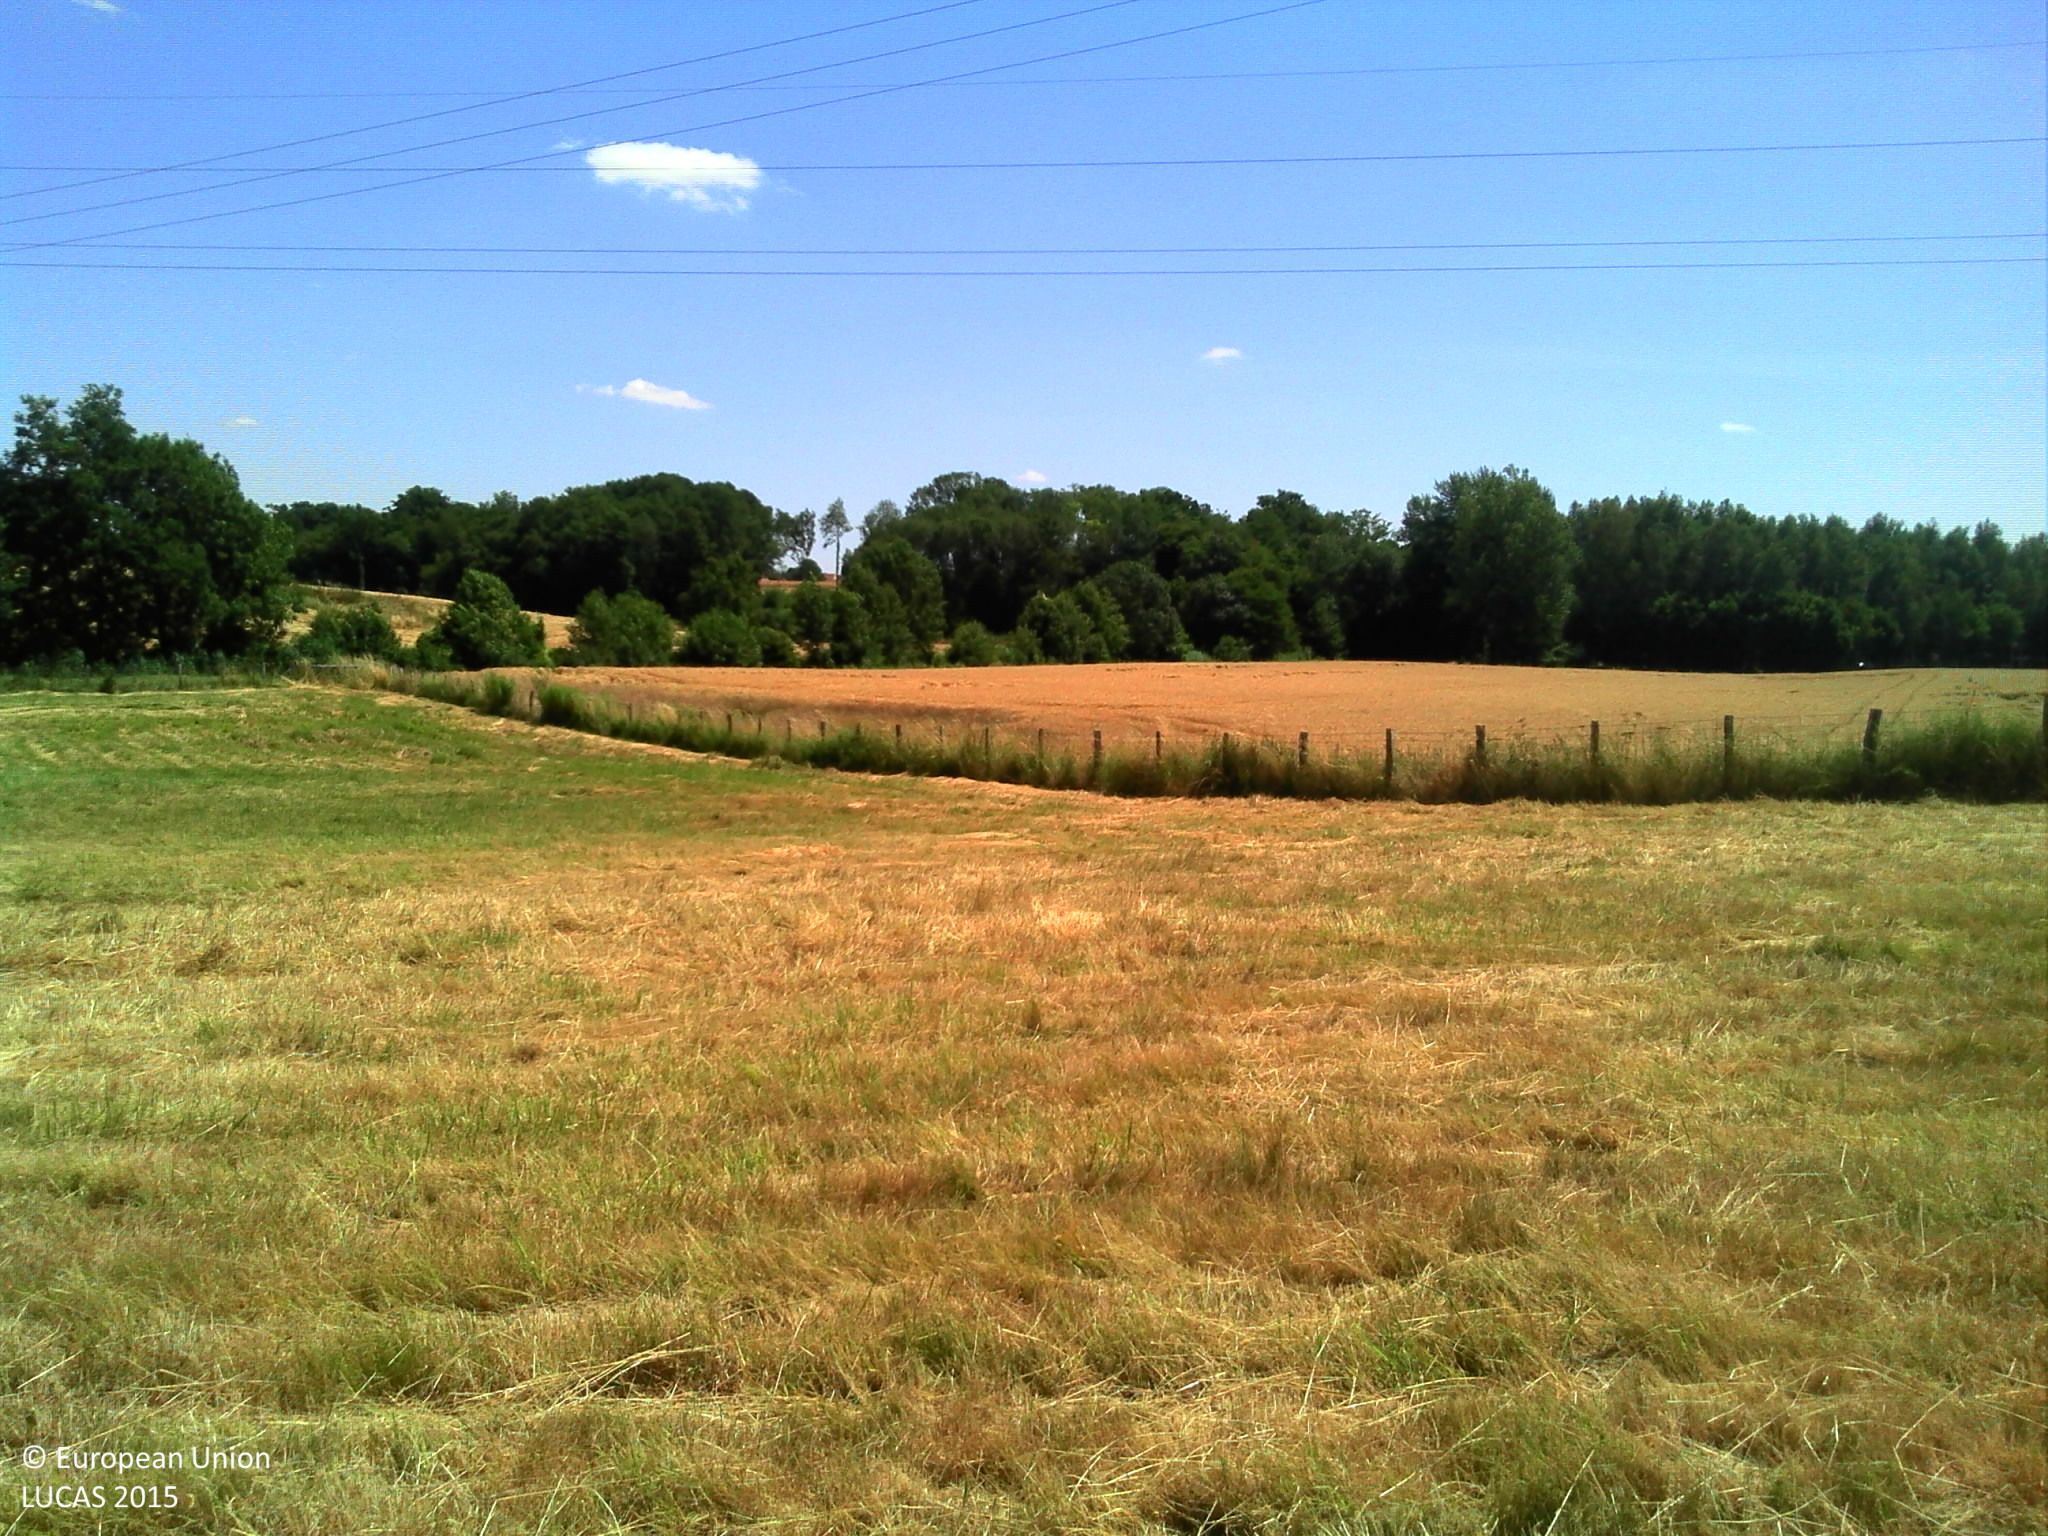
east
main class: Grassland
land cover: Grassland without tree/shrub cover
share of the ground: > 75 %
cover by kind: herbaceous plants 100 %
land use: Agriculture (excluding fallow land and kitchen gardens)
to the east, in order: Grassland without tree/shrub cover; Electric lines; Grassland without tree/shrub cover; Fences; Durum wheat; Electric lines; Durum wheat; Grassland without tree/shrub cover; Lines of trees; Rivers and streams; Lines of trees; Fences; Grassland without tree/shrub cover
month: July
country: FR
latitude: 48.0425
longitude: 3.0852
